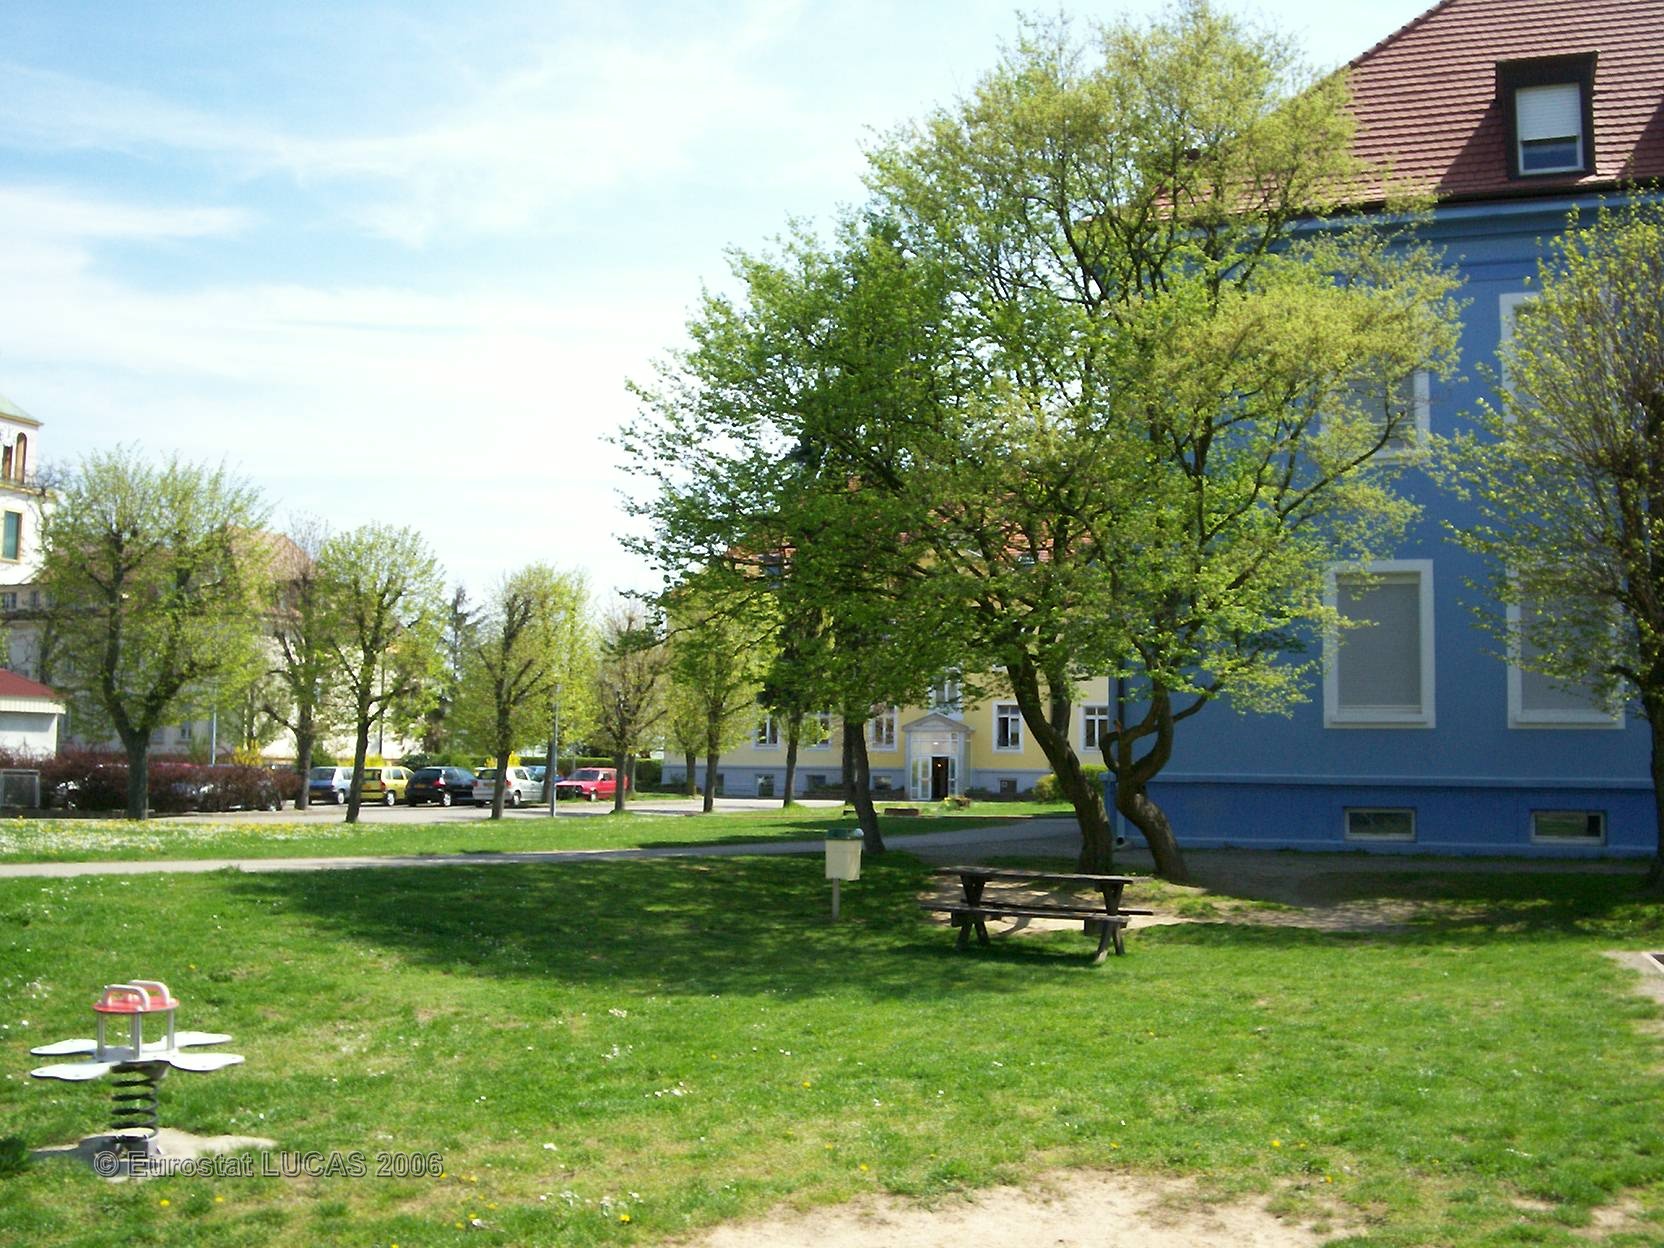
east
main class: Grassland
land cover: Grassland without tree/shrub cover
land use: Amenities, museums, leisure
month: April
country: FR
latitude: 47.7908
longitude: 7.1581
